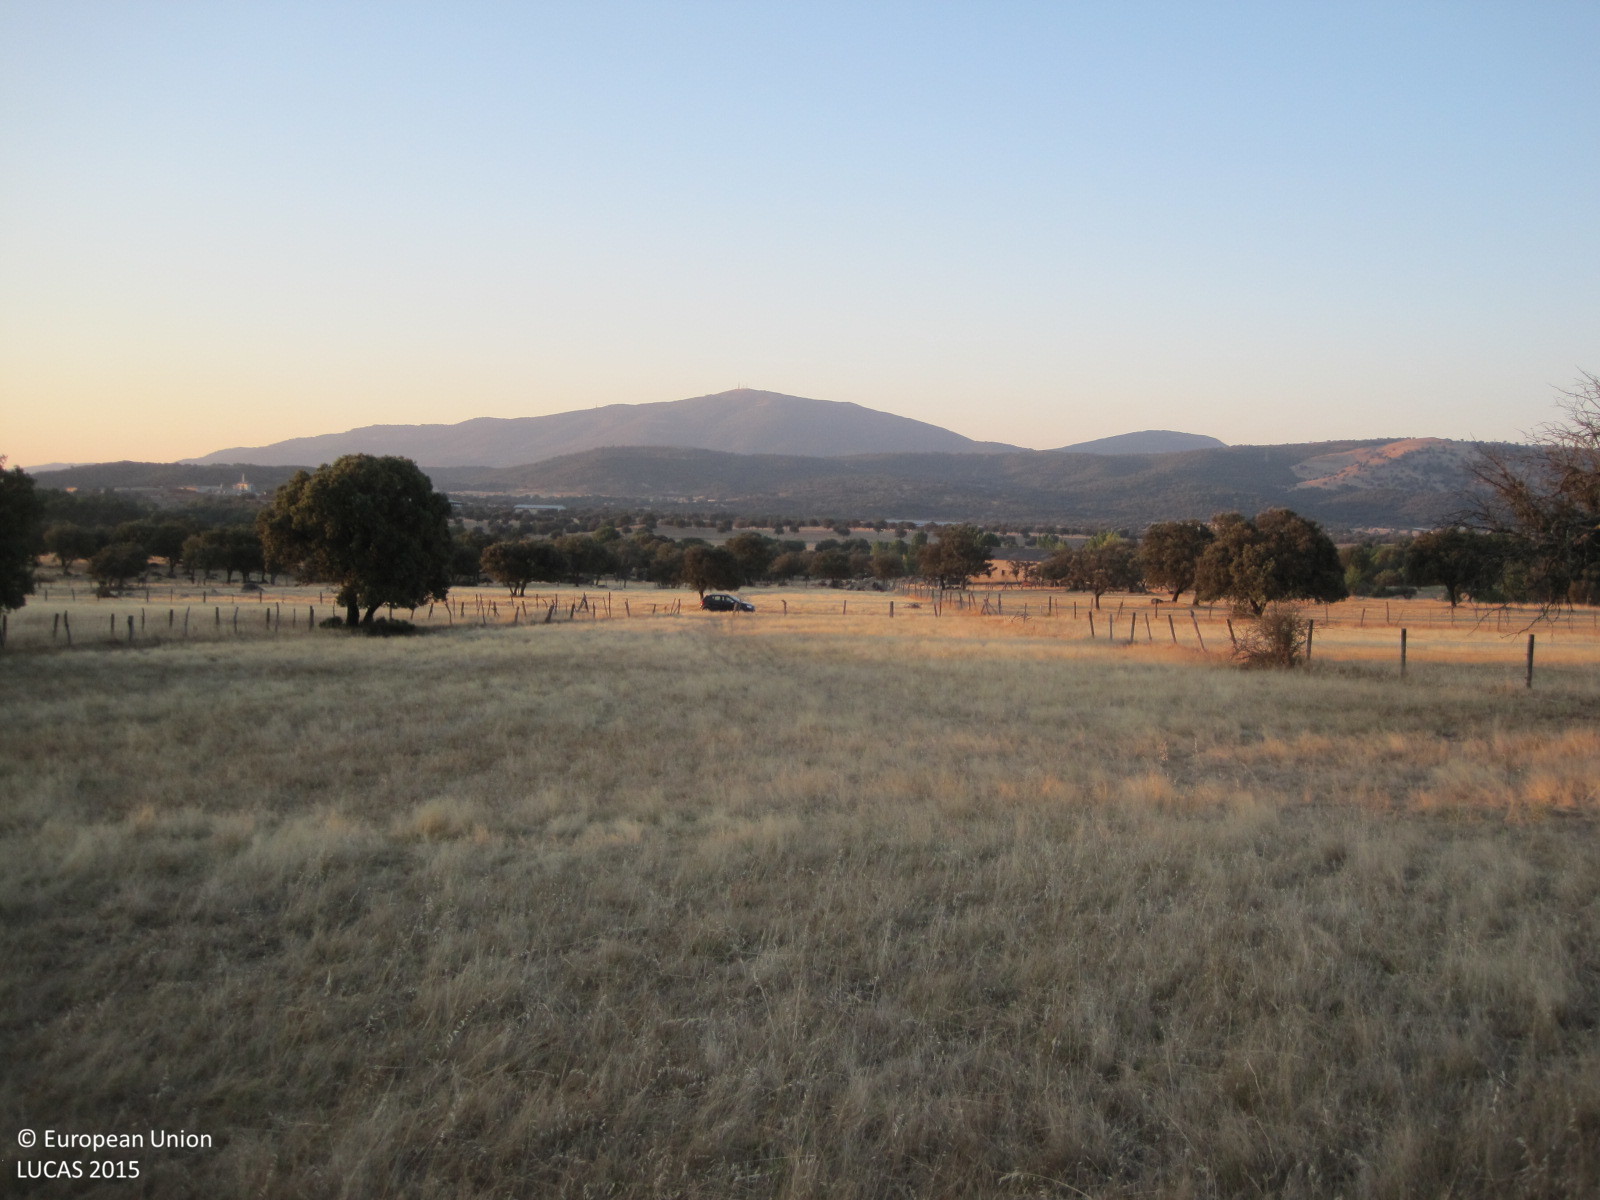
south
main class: Grassland
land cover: Grassland with sparse tree/shrub cover
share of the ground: > 75 %
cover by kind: herbaceous plants 95 %, broadleaved forest trees 5 %
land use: Agriculture (excluding fallow land and kitchen gardens)
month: July
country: ES
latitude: 40.2353
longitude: -4.8261
